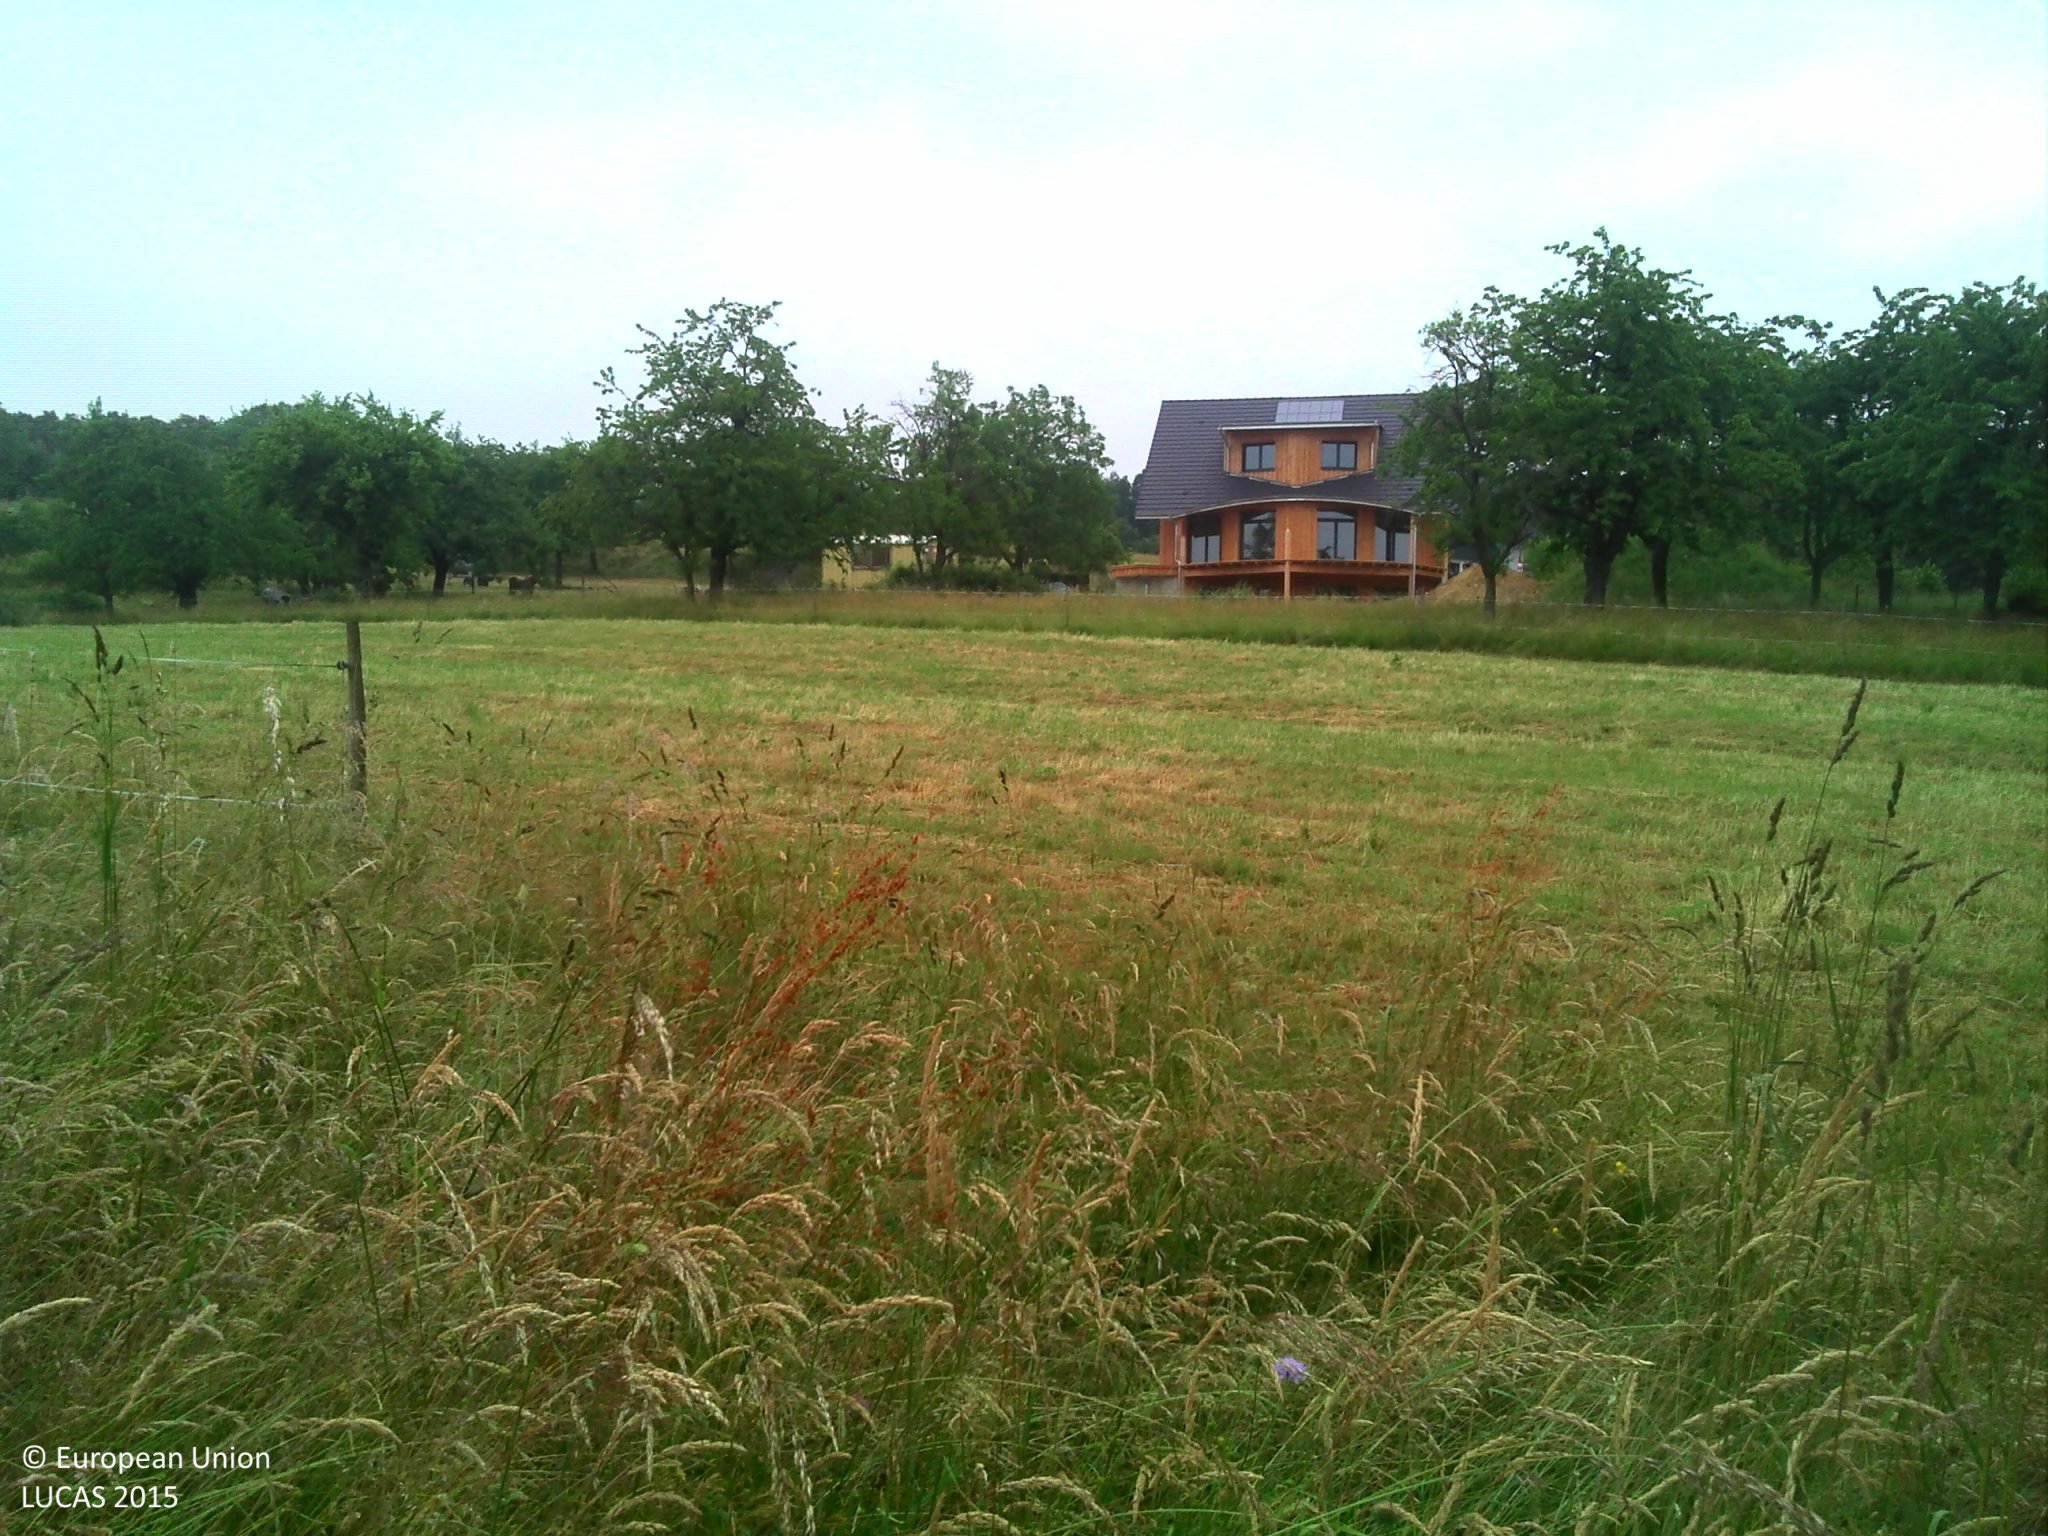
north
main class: Grassland
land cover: Grassland with sparse tree/shrub cover
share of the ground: > 75 %
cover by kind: herbaceous plants 95 %, broadleaved forest trees 5 %
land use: Agriculture (excluding fallow land and kitchen gardens)
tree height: > 5 m
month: June
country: FR
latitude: 47.5089
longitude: 7.4126
